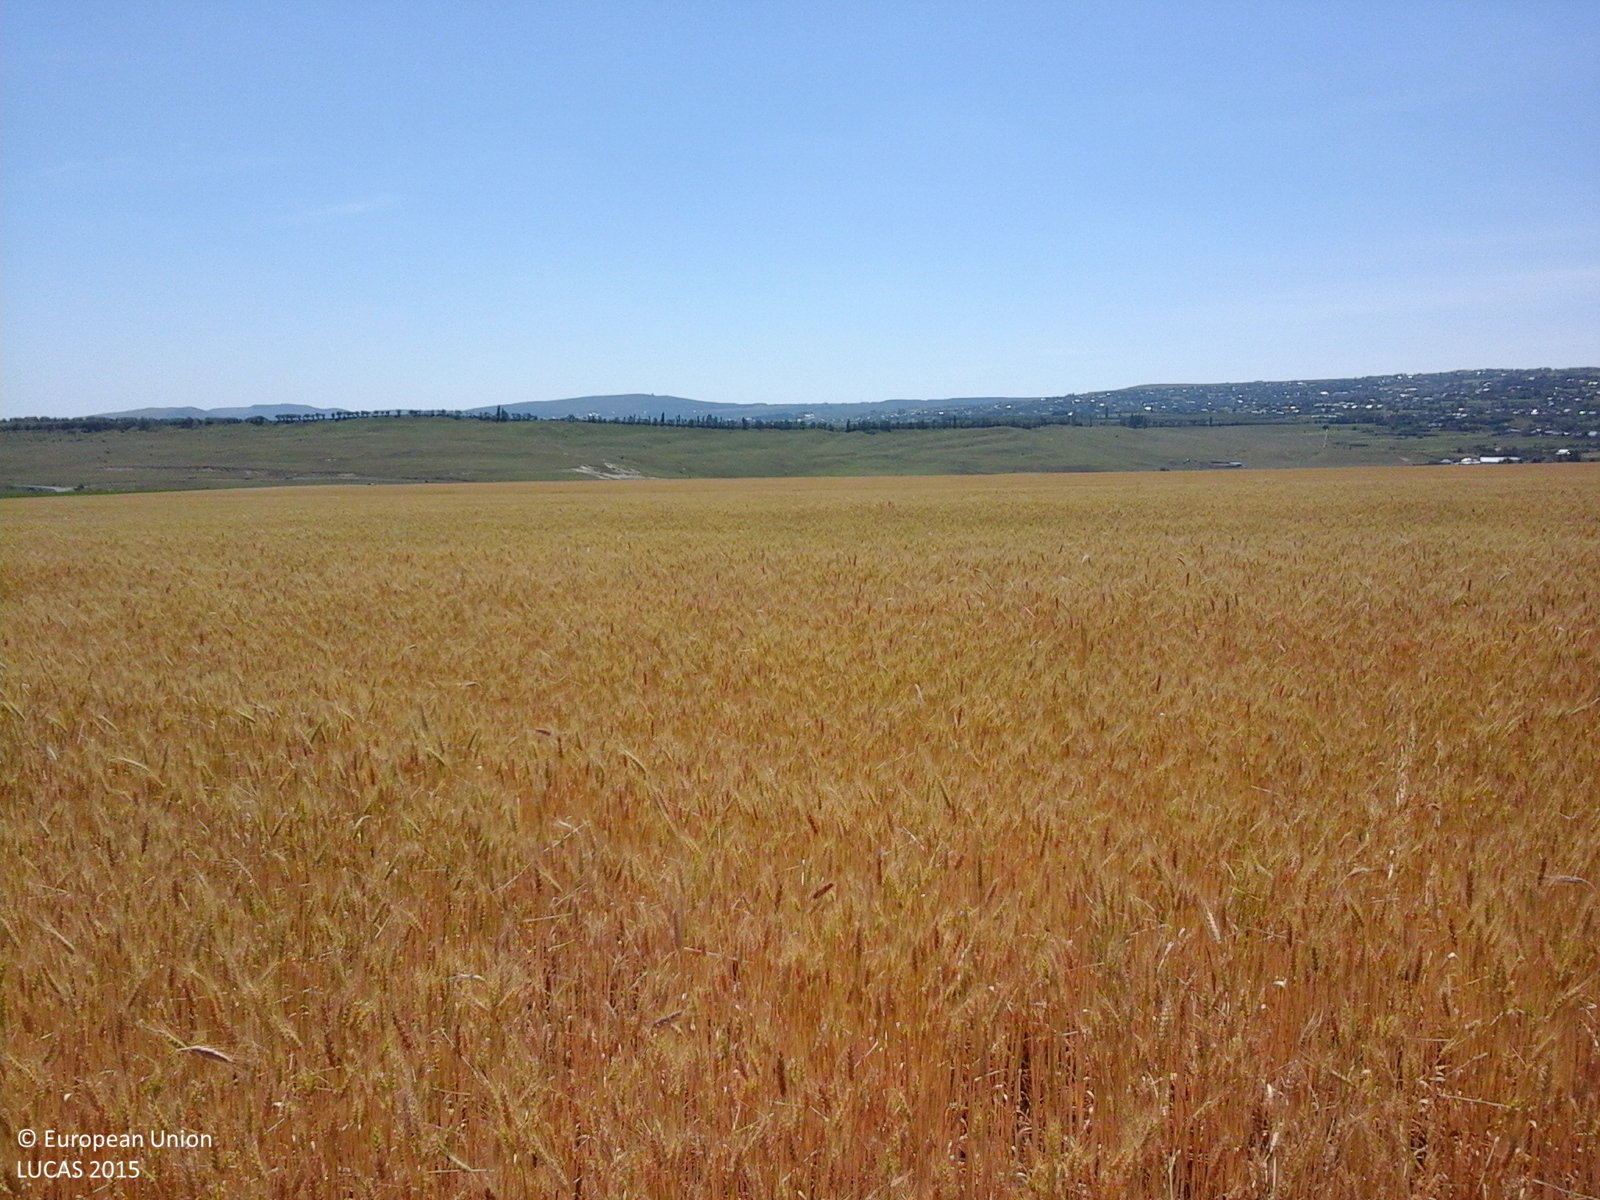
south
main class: Cropland
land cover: Durum wheat
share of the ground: > 75 %
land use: Agriculture (excluding fallow land and kitchen gardens)
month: June
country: RO
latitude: 47.4915
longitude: 26.9176
